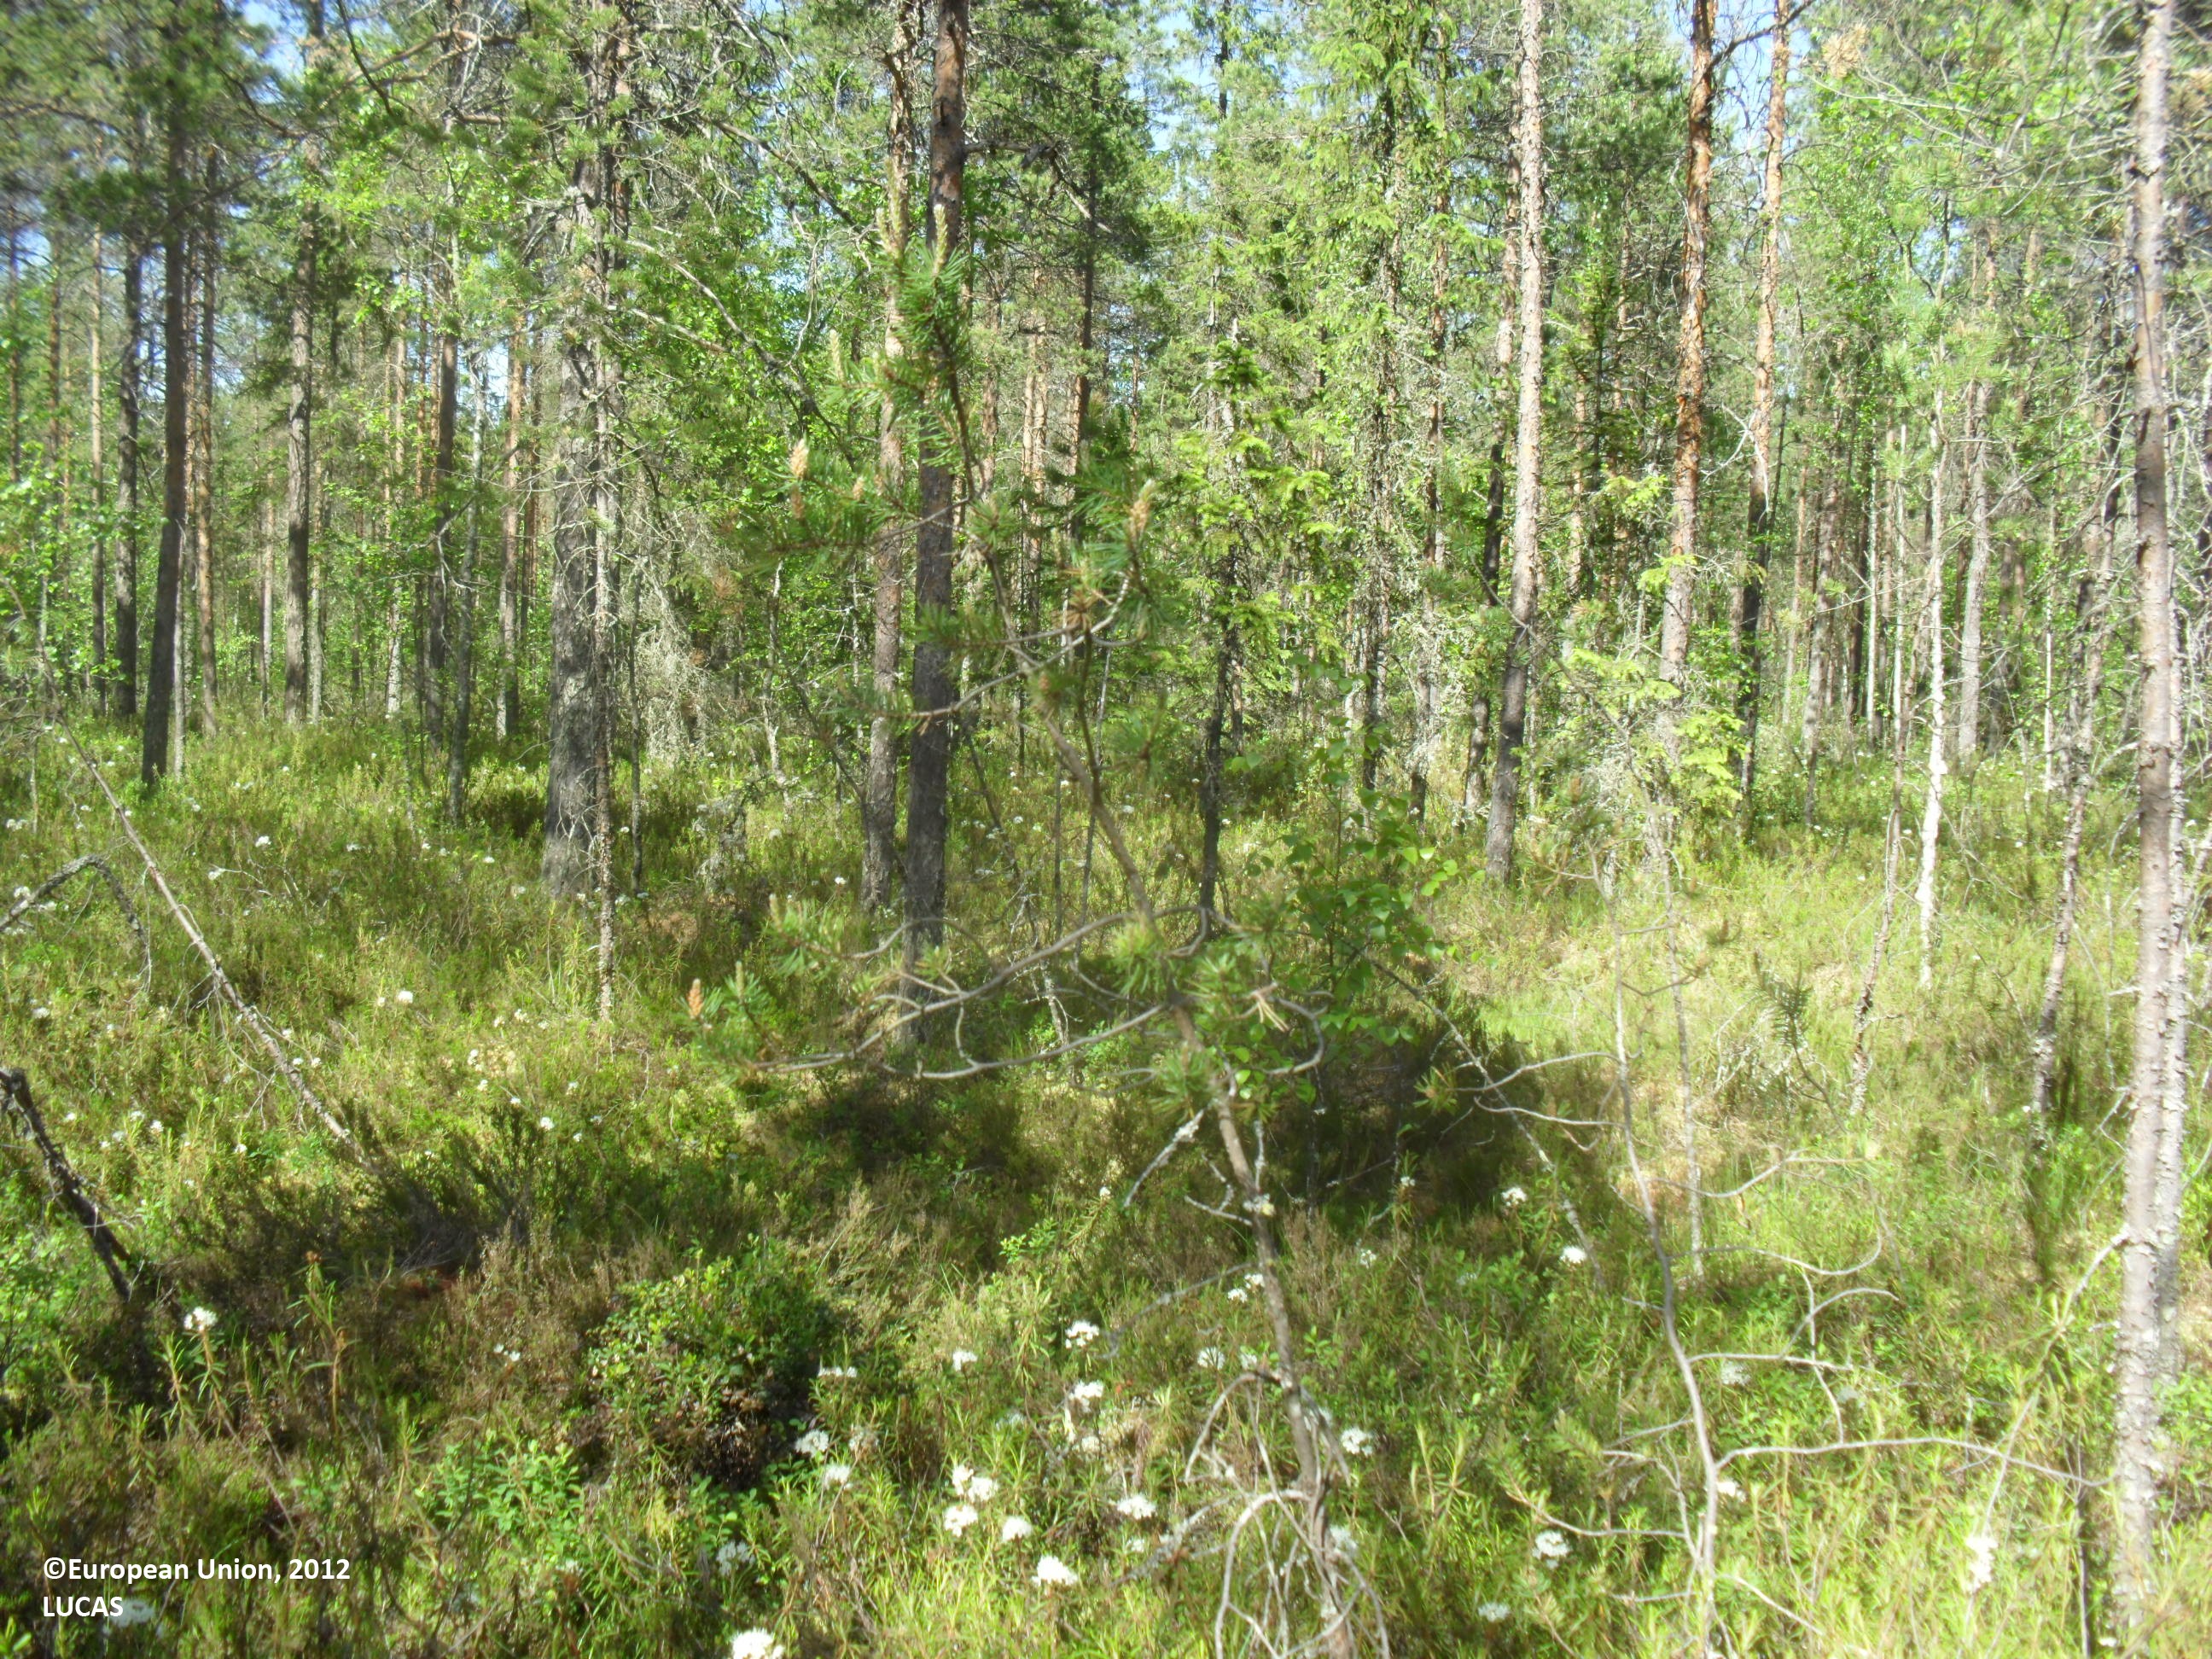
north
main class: Woodland
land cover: Pine dominated mixed woodland
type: boreal forest
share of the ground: 25 - 50 %
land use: Forestry
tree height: > 5 m
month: June
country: FI
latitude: 63.1871
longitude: 23.1543
